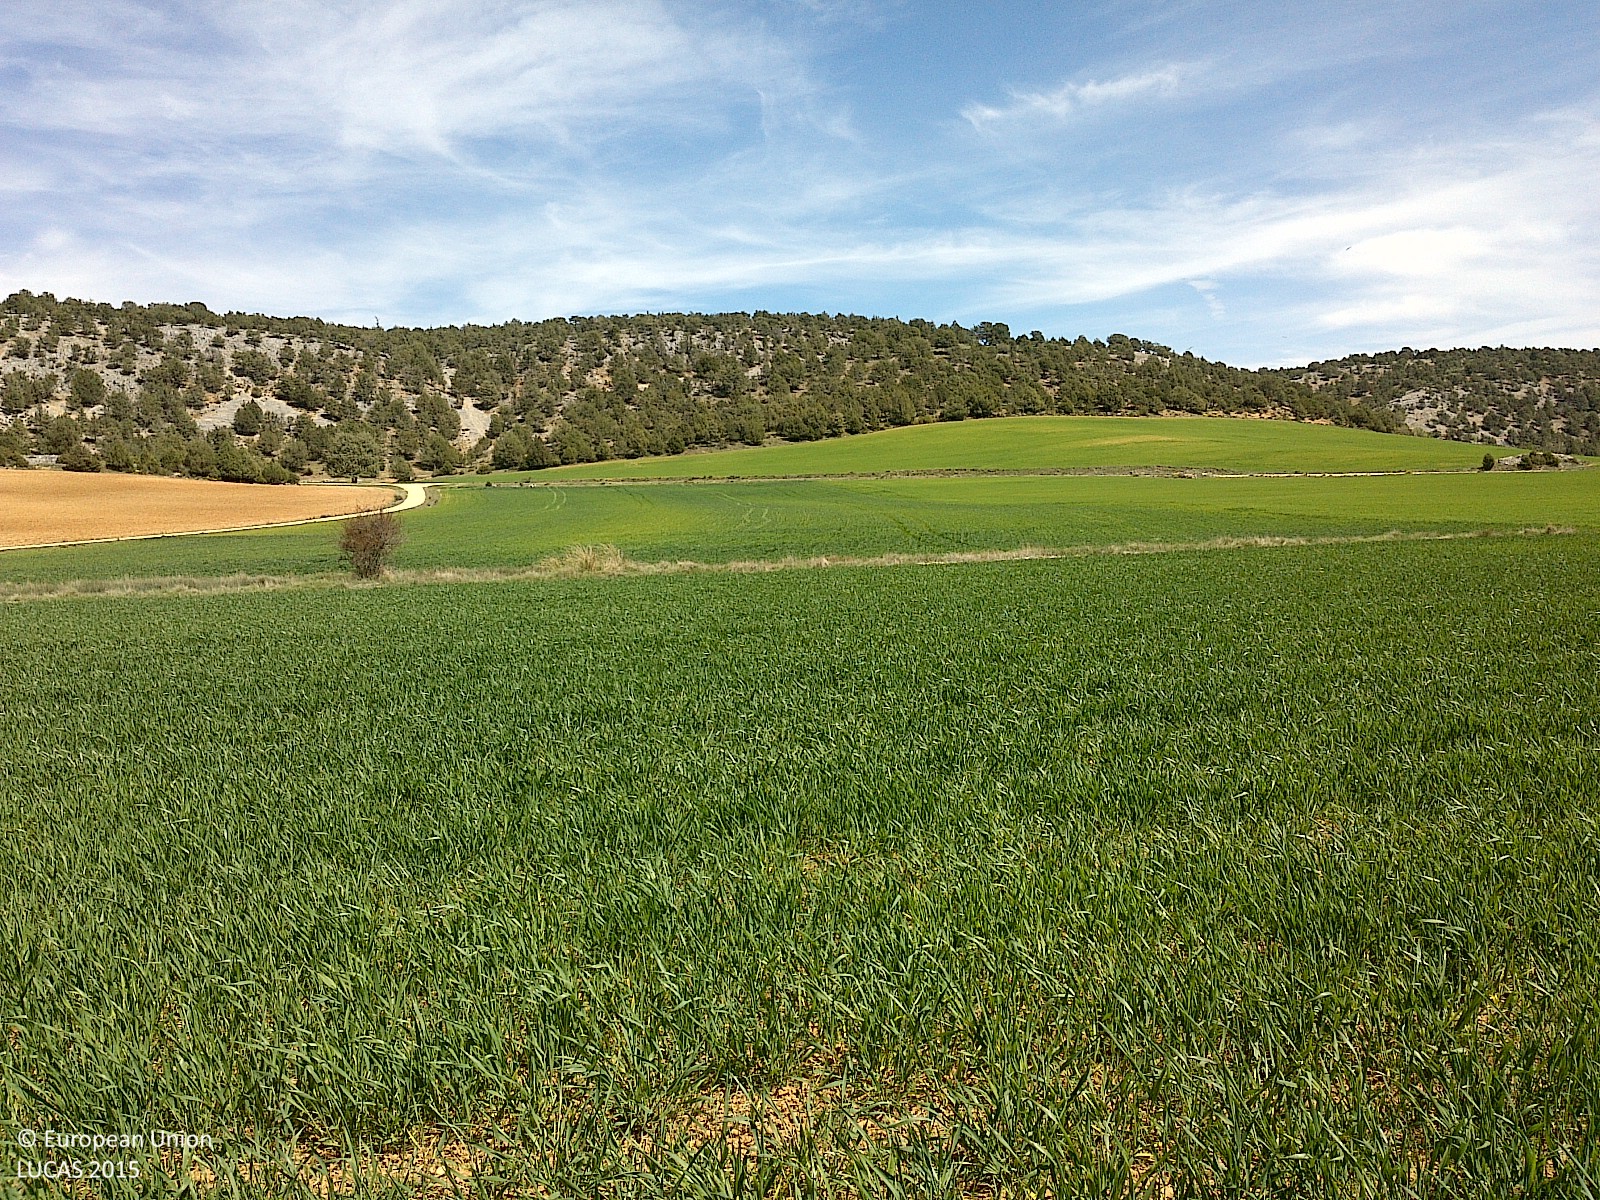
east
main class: Cropland
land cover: Barley
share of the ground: 50 - 75 %
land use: Agriculture (excluding fallow land and kitchen gardens)
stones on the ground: < 10 %
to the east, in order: Barley; Ditches and canals; Barley
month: April
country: ES
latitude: 41.7829
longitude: -3.2226
